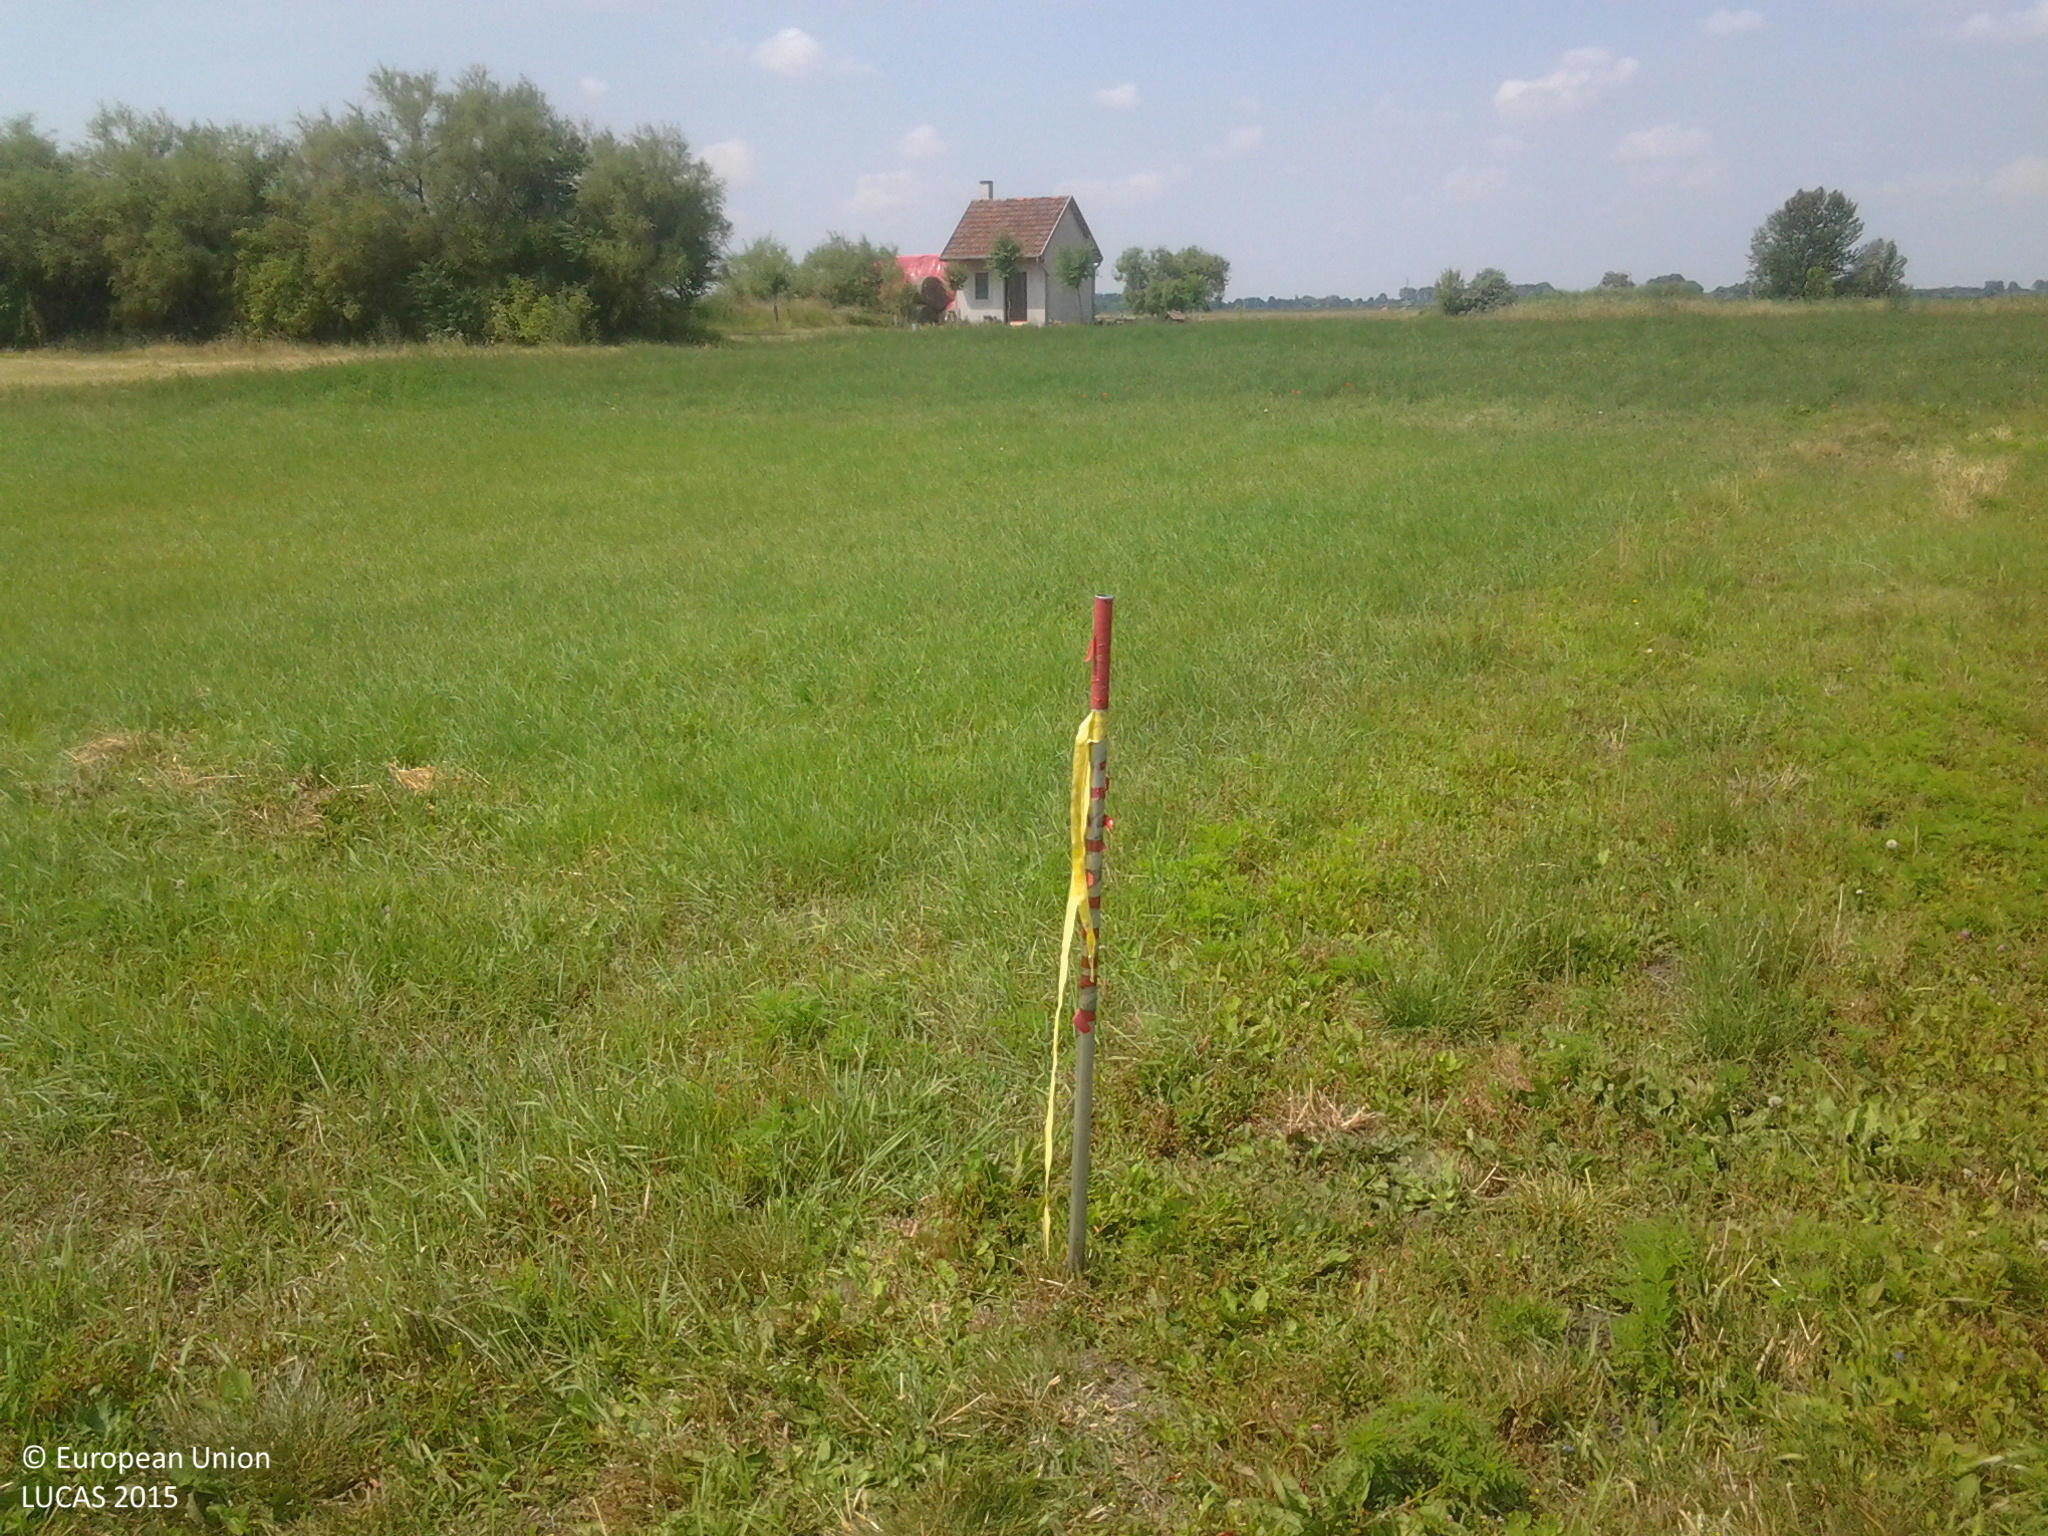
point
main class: Grassland
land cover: Grassland without tree/shrub cover
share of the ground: > 75 %
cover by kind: herbaceous plants 100 %
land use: Agriculture (excluding fallow land and kitchen gardens)
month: June
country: HU
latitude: 46.7631
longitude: 19.2738
